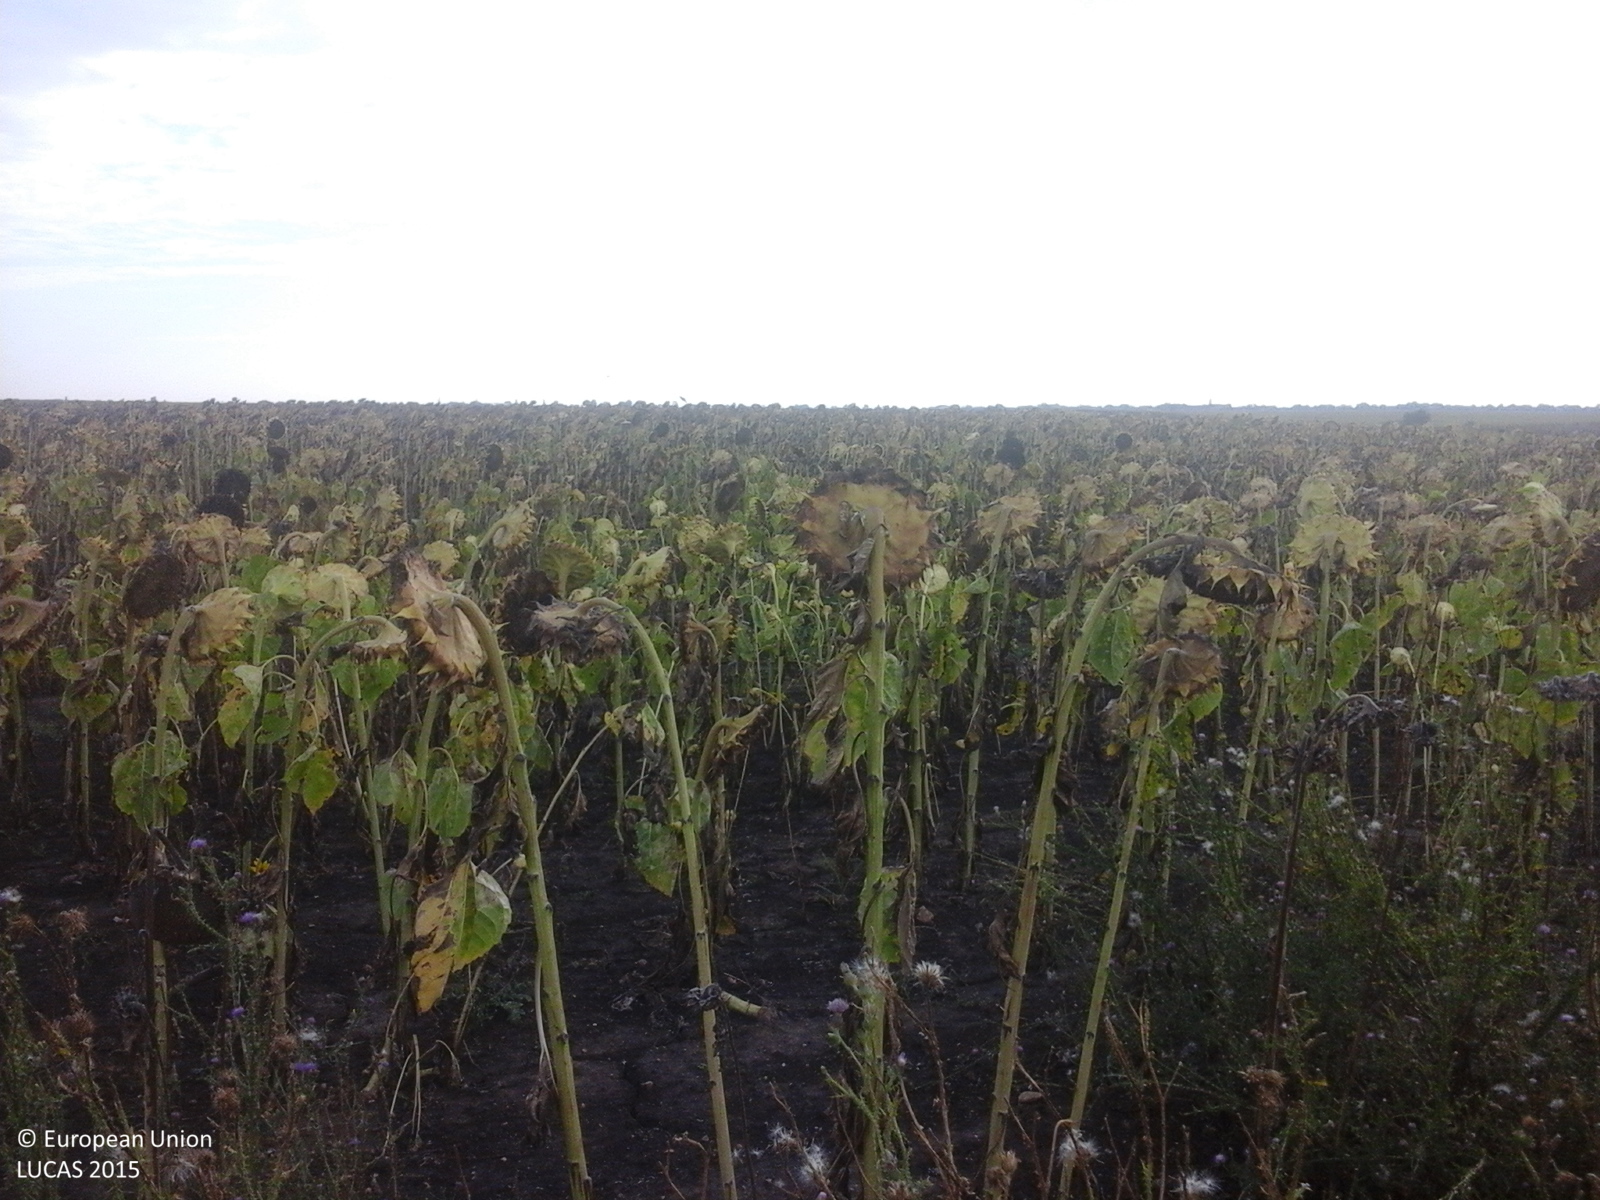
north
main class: Cropland
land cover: Sunflower
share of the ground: > 75 %
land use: Agriculture (excluding fallow land and kitchen gardens)
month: August
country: RO
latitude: 46.2886
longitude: 21.3667
